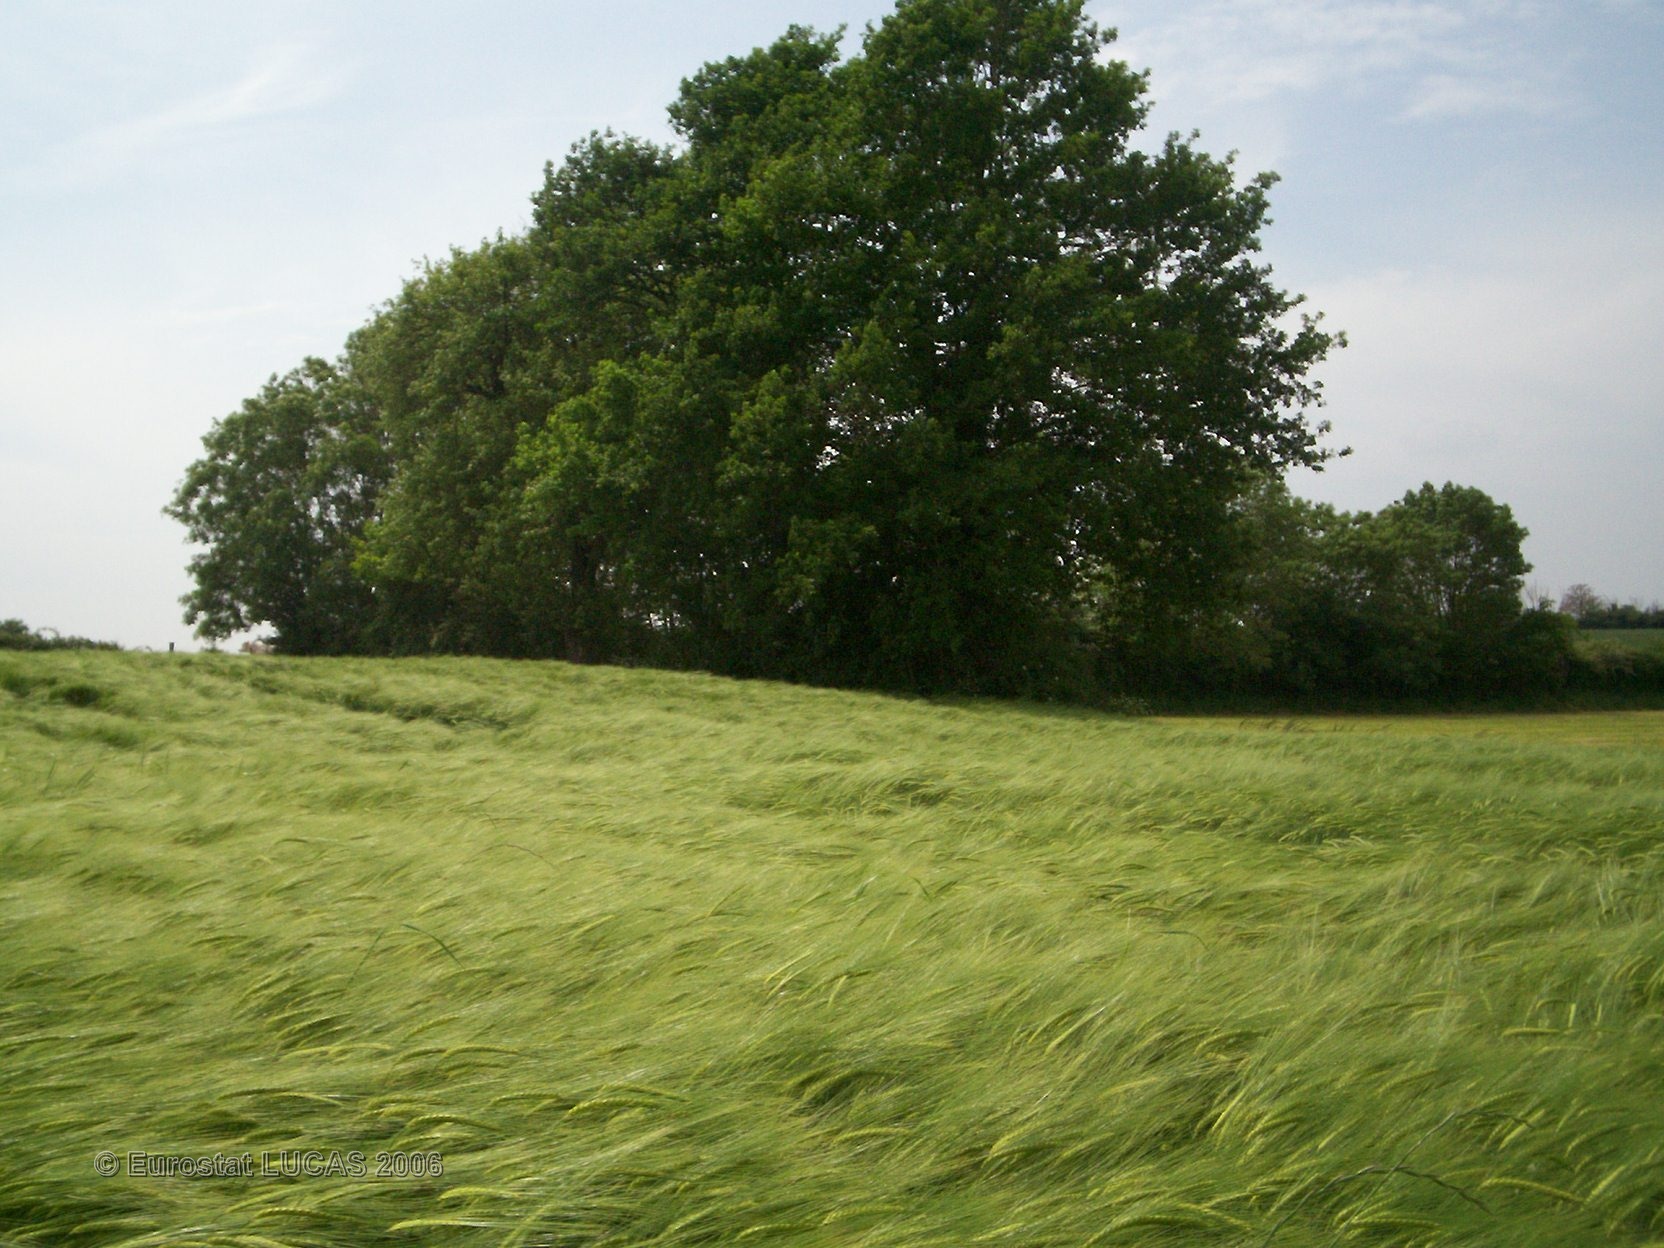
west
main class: Cropland
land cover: Barley
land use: Agriculture (excluding fallow land and kitchen gardens)
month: May
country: FR
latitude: 46.6322
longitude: -0.8593
